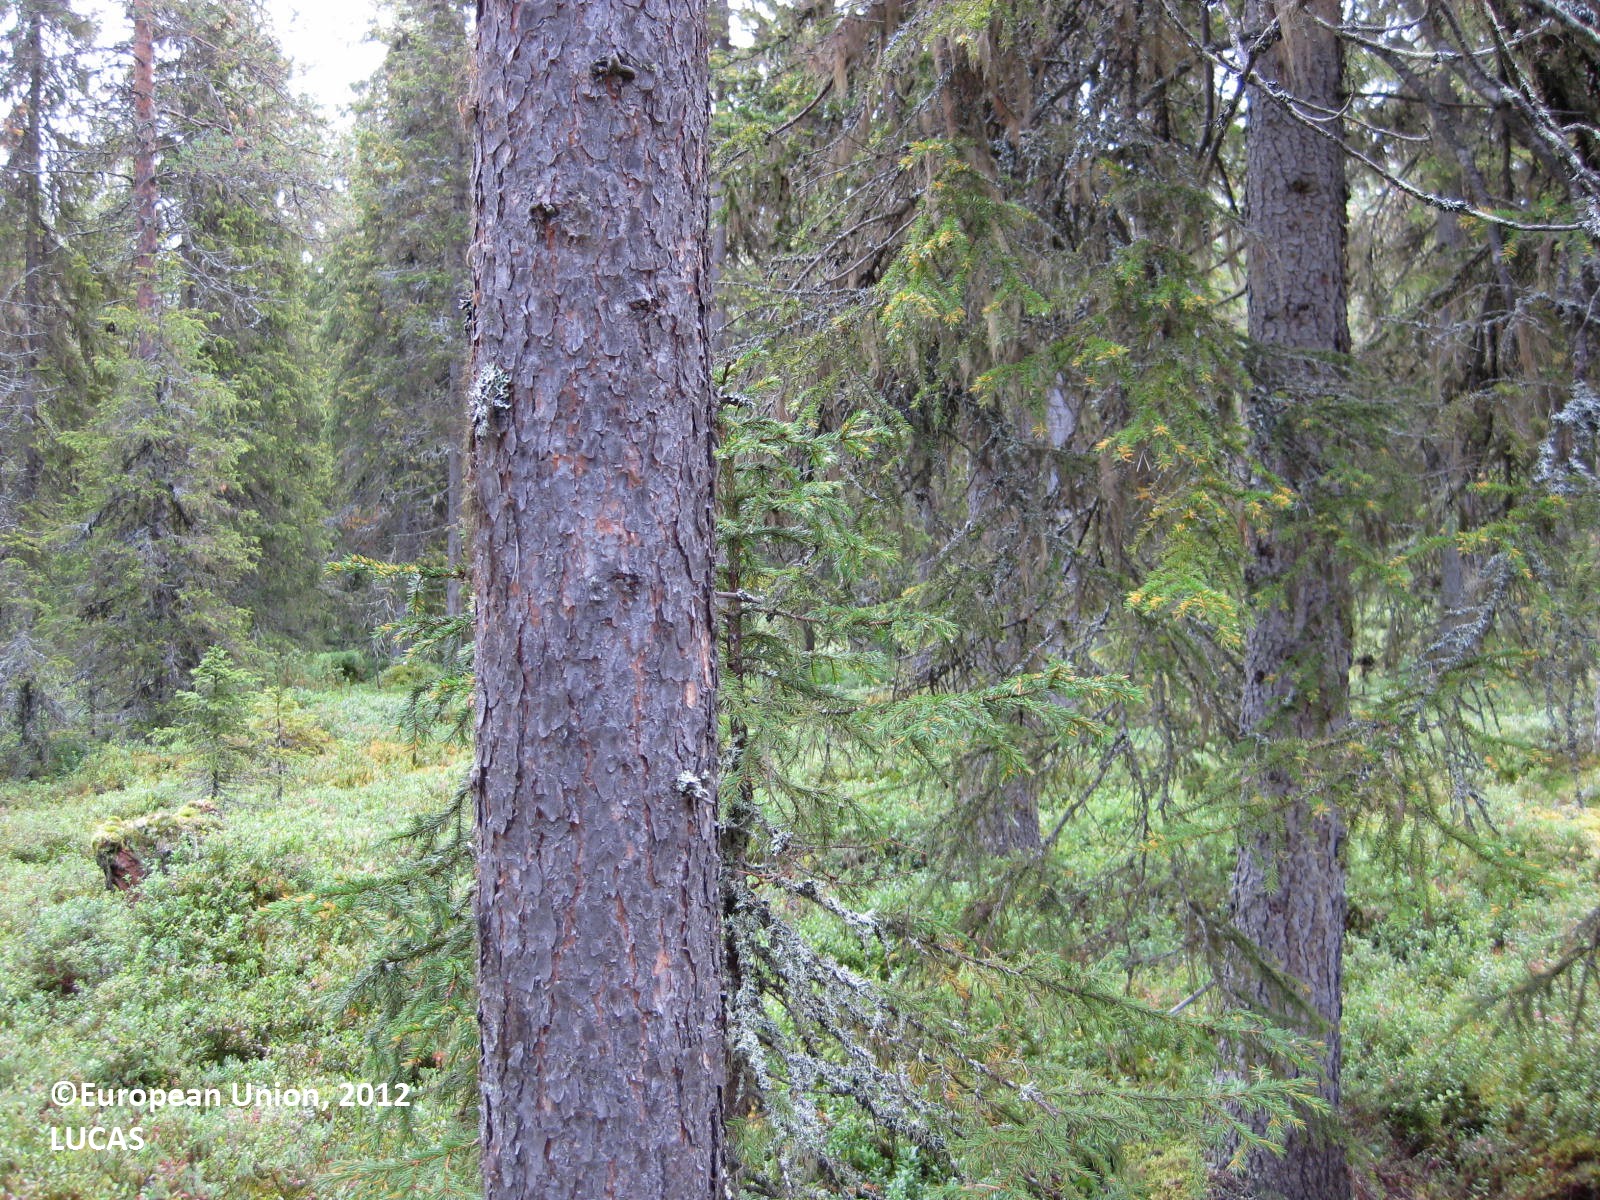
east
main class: Woodland
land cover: Other coniferous woodland
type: boreal forest
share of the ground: 50 - 75 %
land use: Forestry
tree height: > 5 m
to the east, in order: Other coniferous woodland; Spruce dominated coniferous woodland
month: August
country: FI
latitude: 66.0668
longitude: 28.7855
